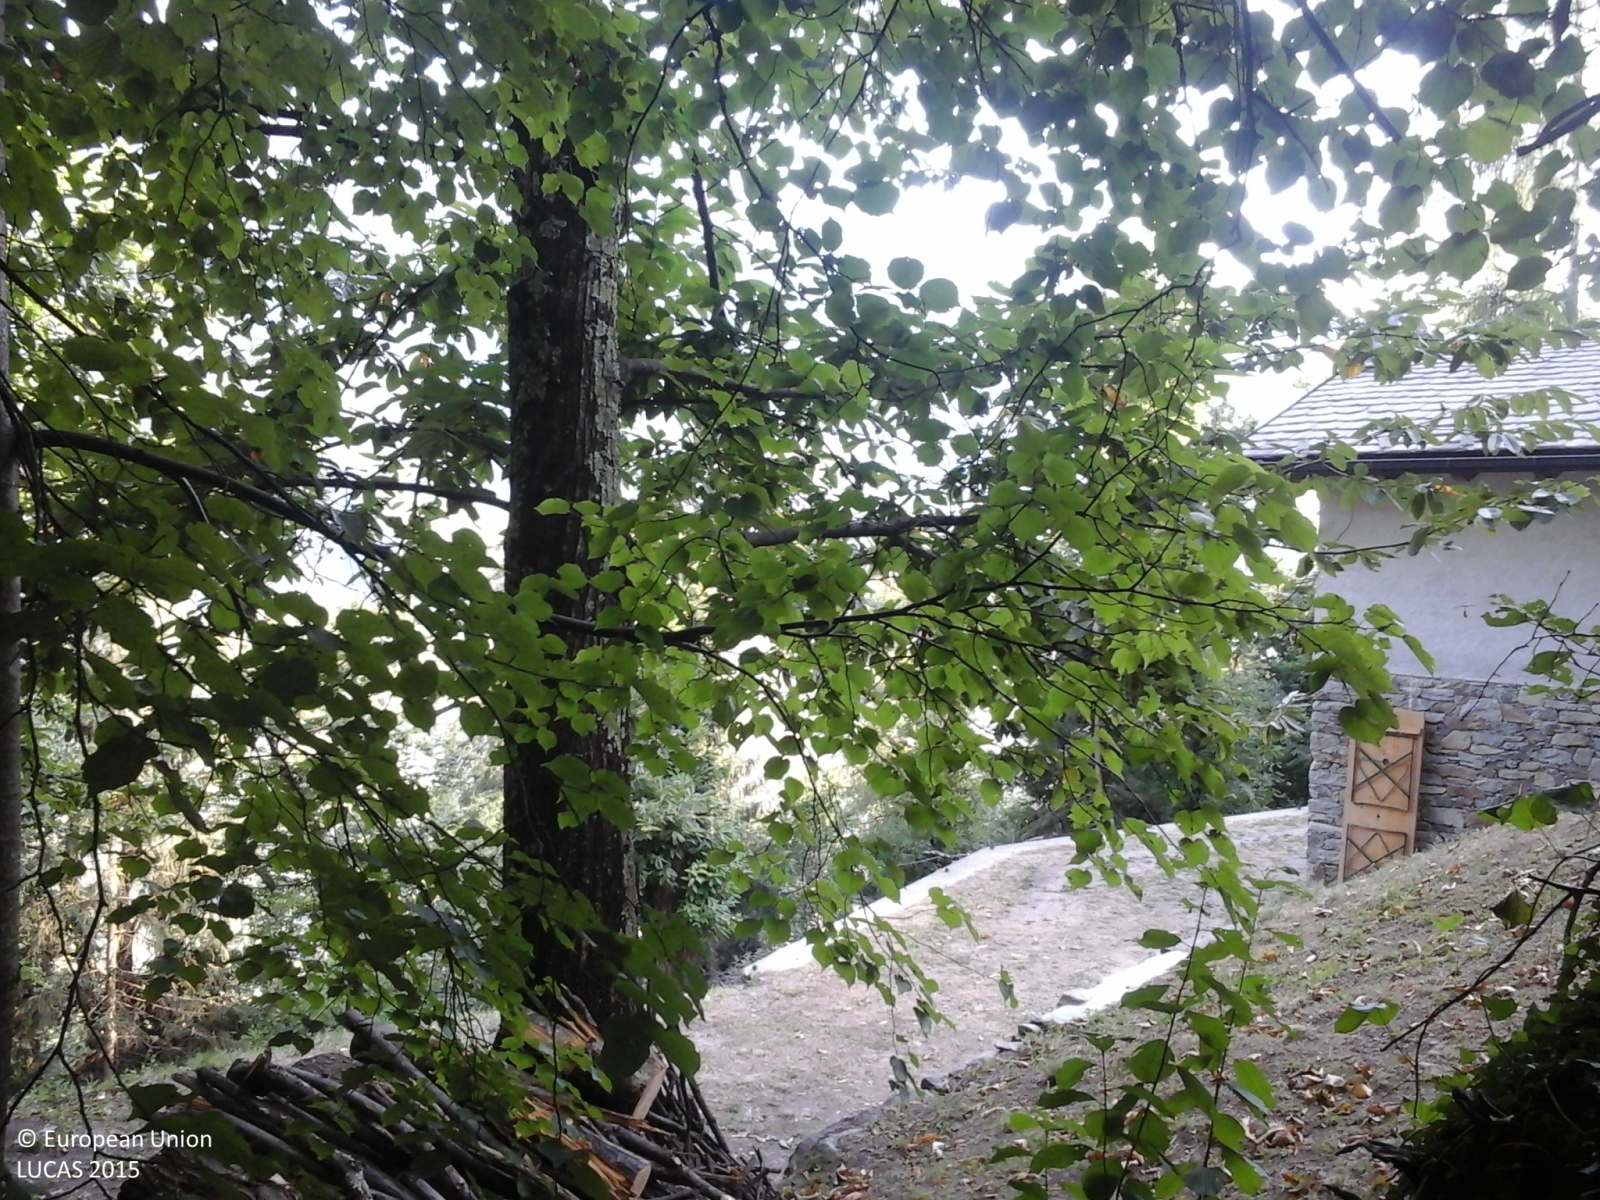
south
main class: Woodland
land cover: Broadleaved woodland
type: mountainous beech forest
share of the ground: > 75 %
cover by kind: broadleaved forest trees 100 %
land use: Semi-natural and natural areas not in use
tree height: > 5 m
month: July
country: IT
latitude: 46.2429
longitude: 10.2202
